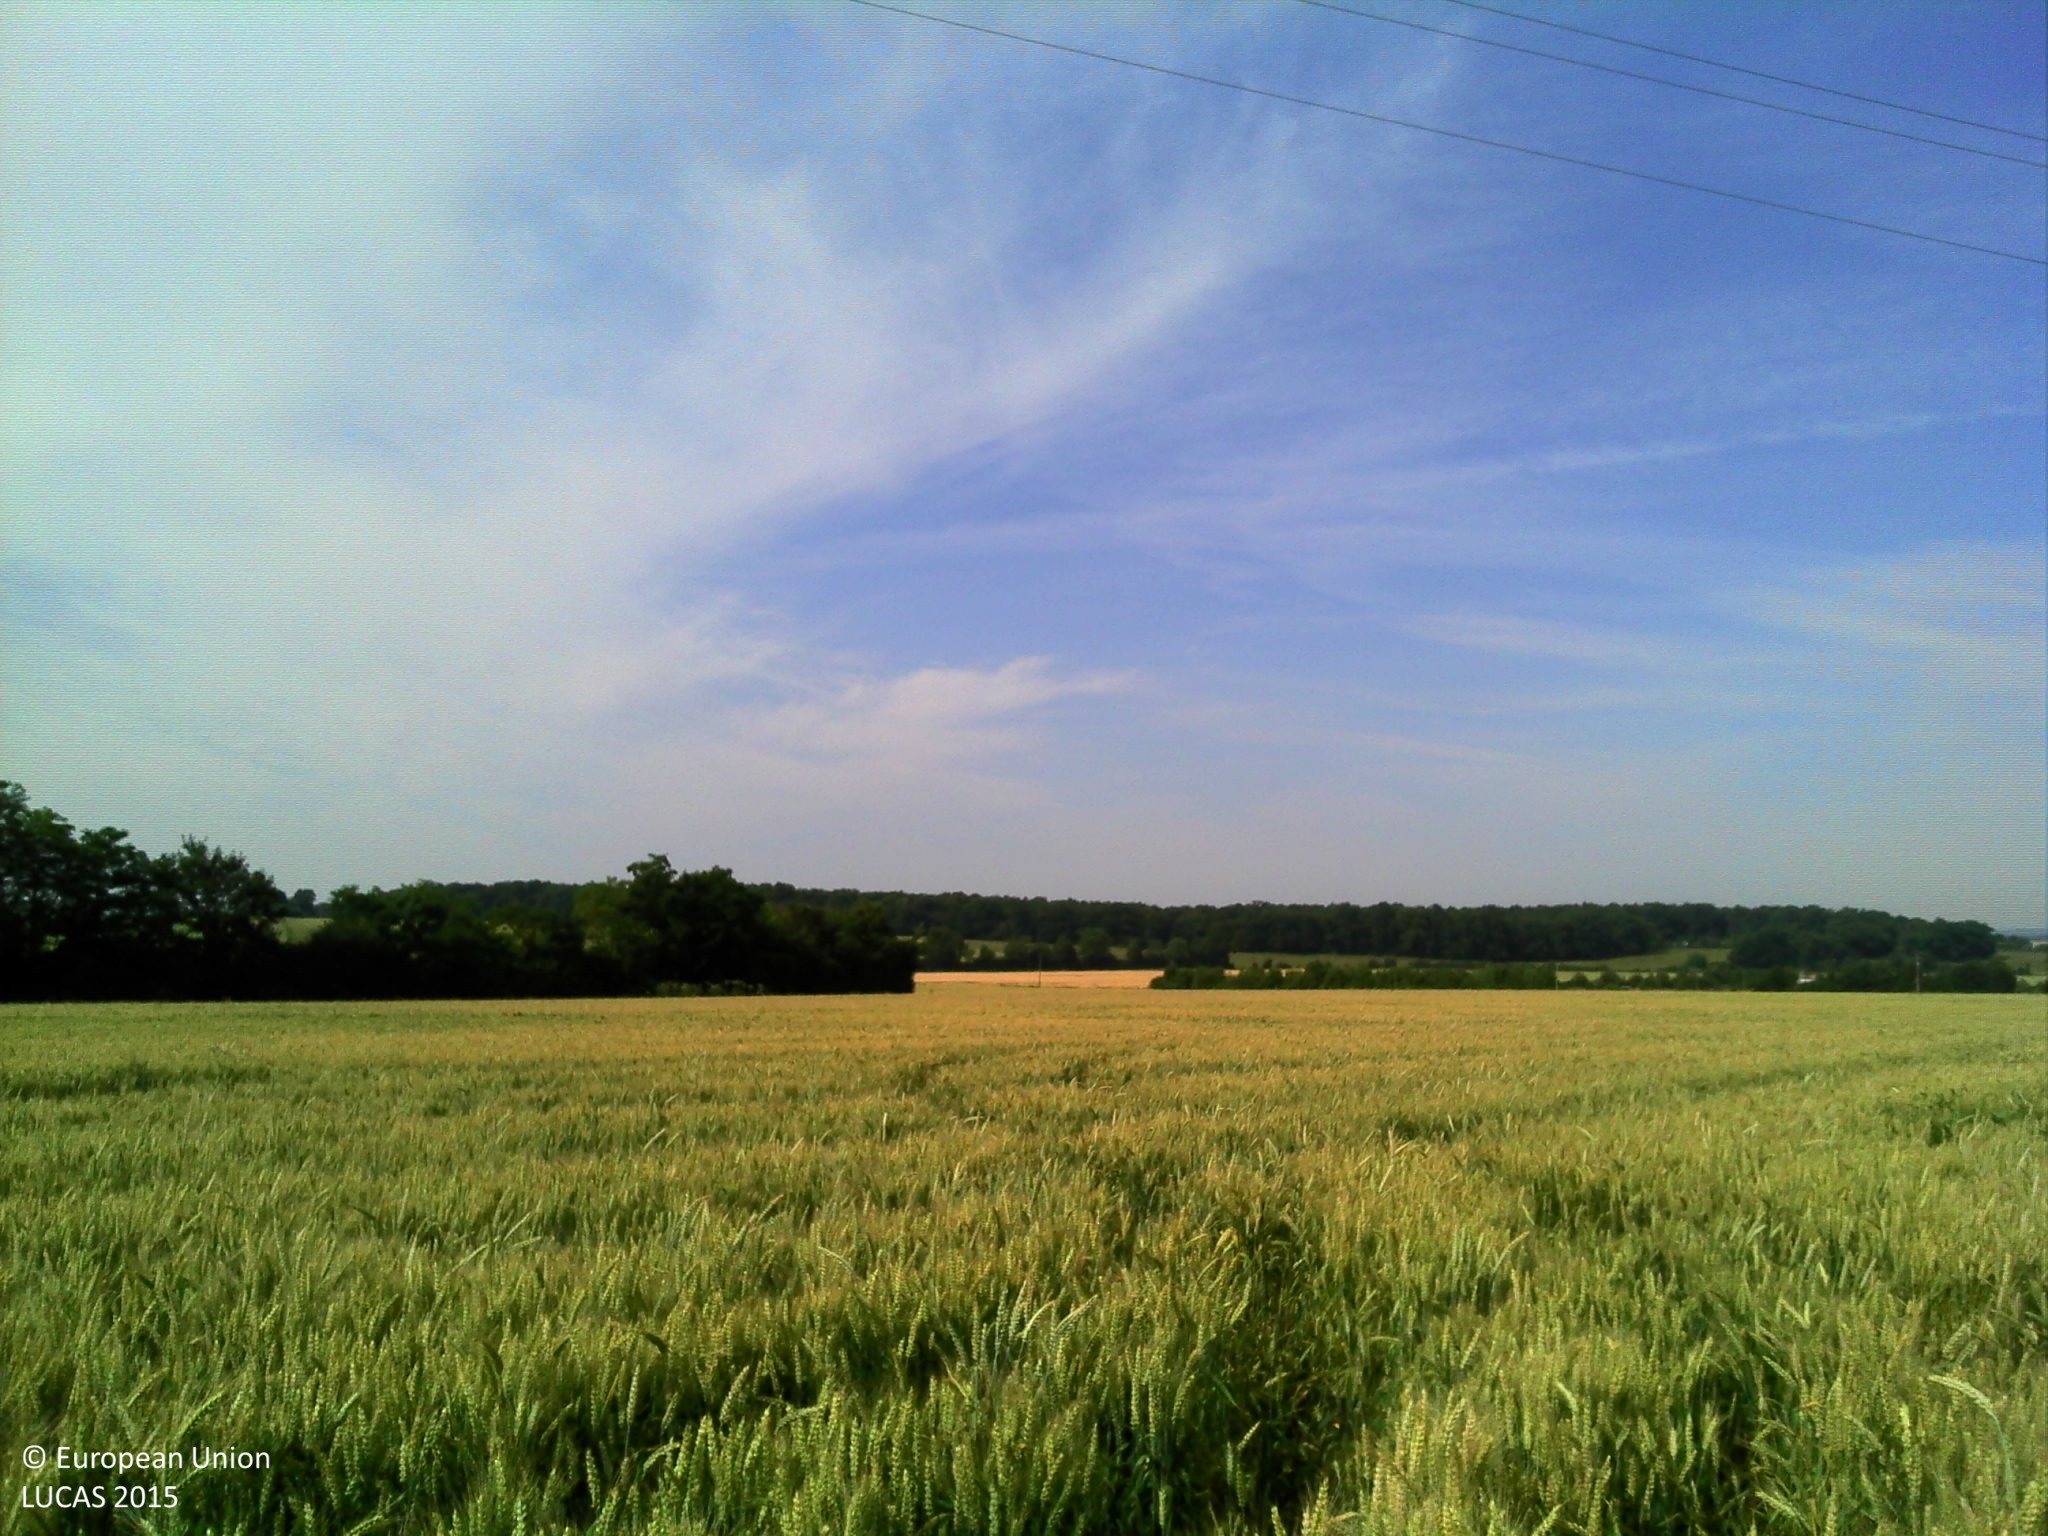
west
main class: Cropland
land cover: Common wheat
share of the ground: > 75 %
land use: Agriculture (excluding fallow land and kitchen gardens)
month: June
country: FR
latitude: 48.3243
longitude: 0.1402
